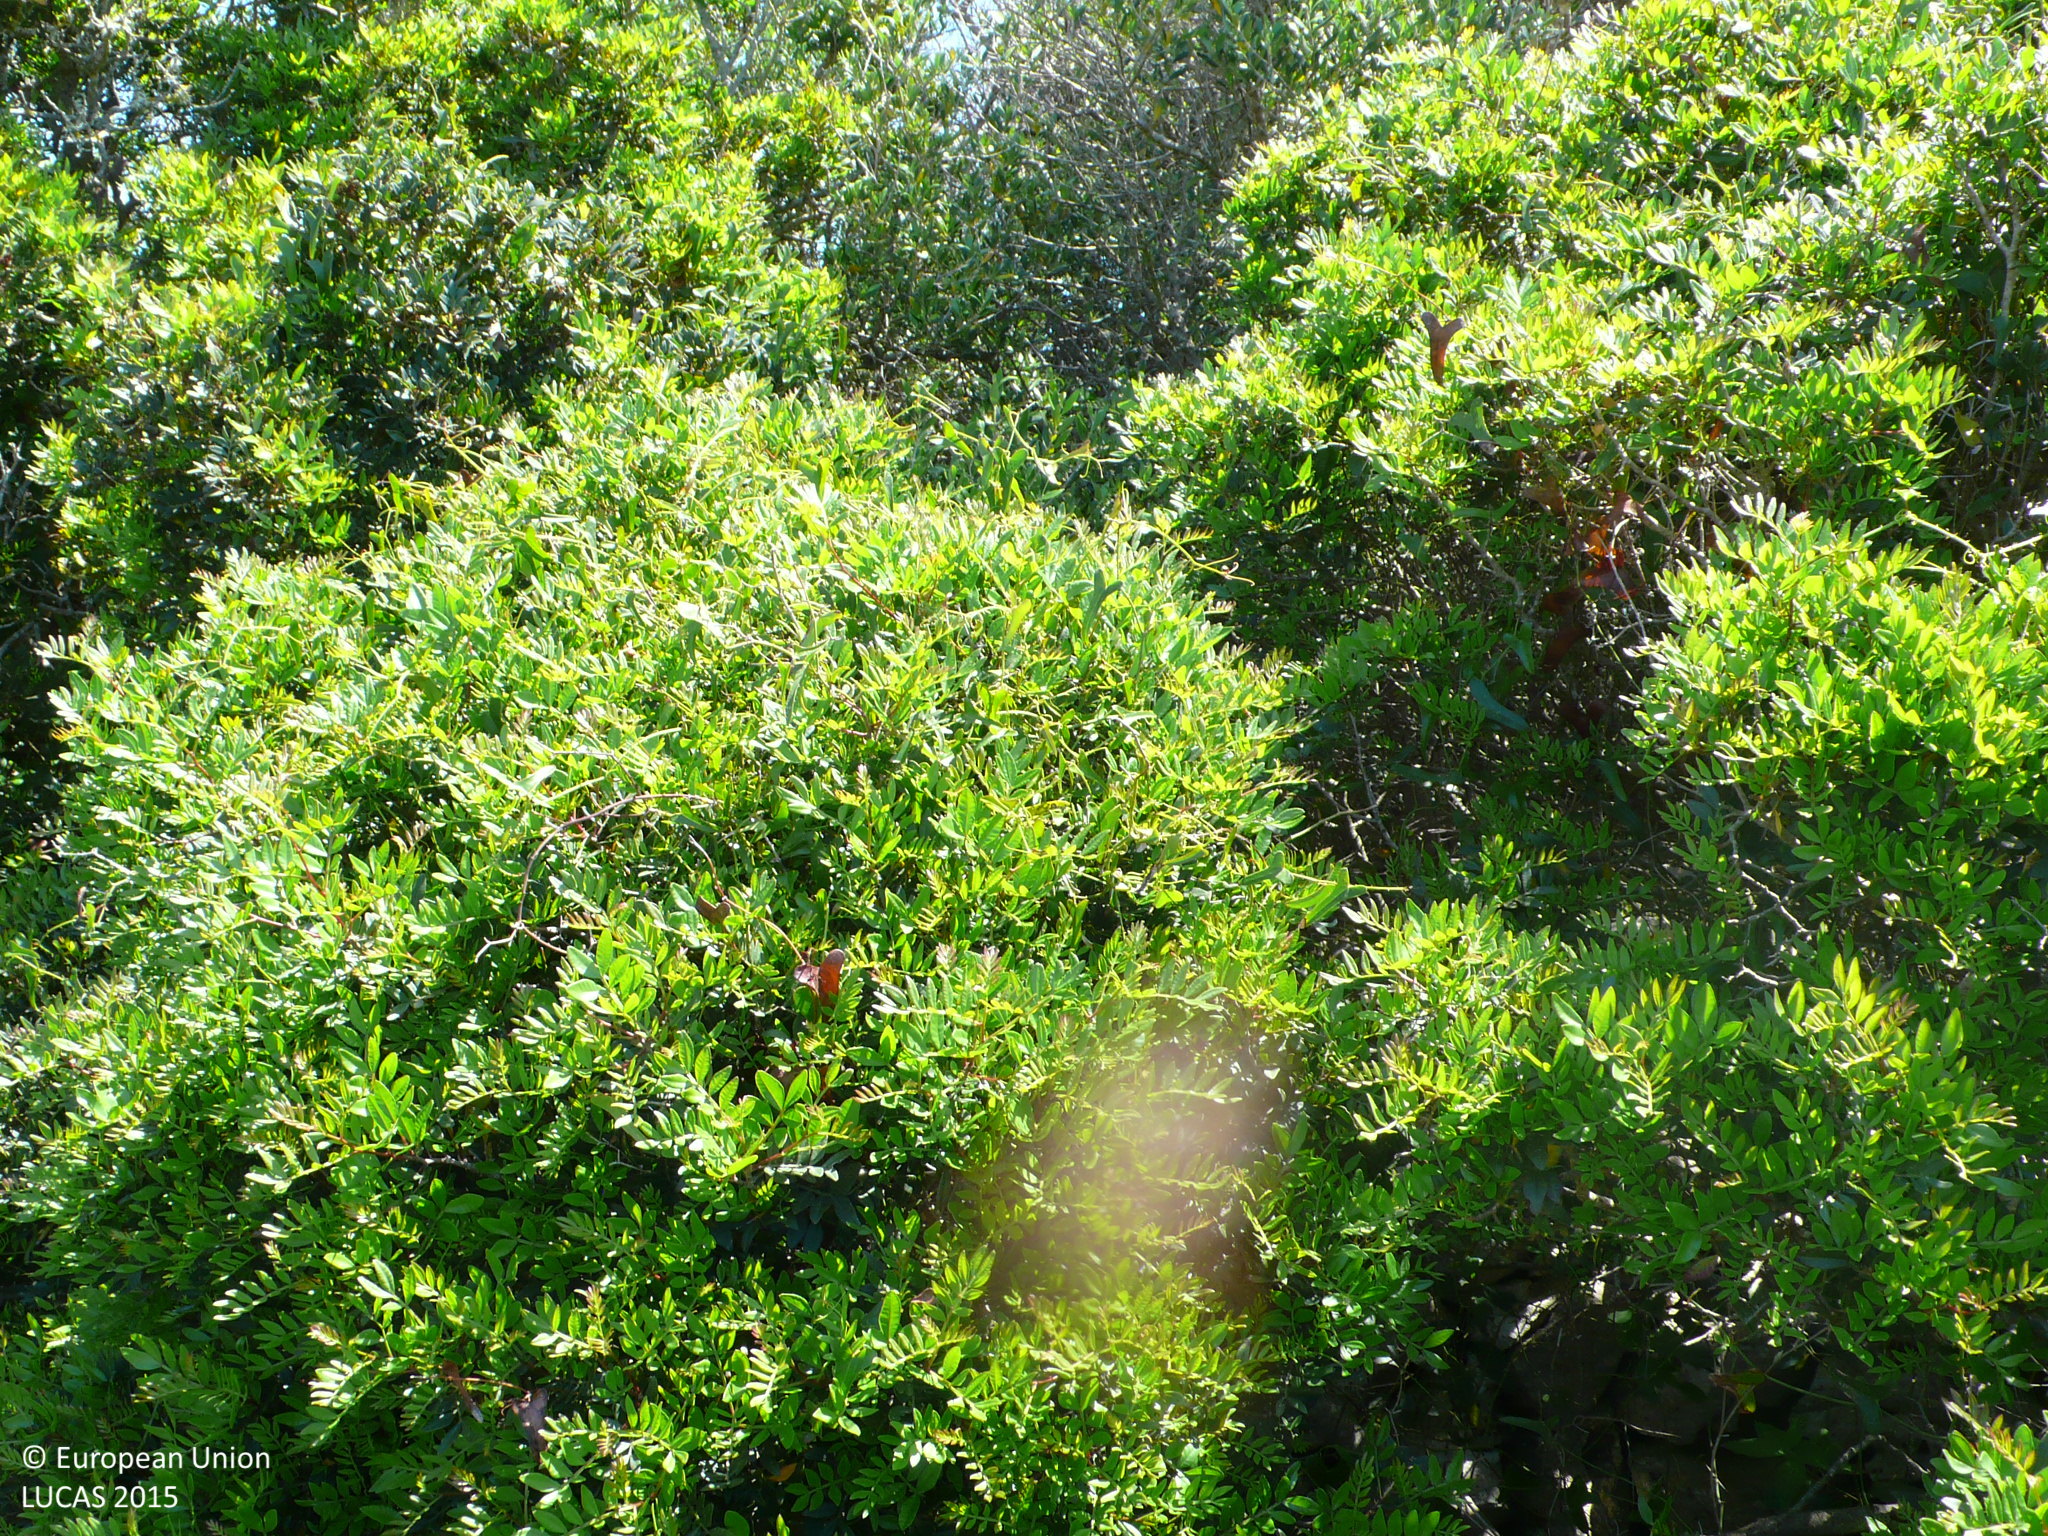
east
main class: Woodland
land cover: Broadleaved woodland
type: broadleaved evergreen forest
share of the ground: 10 - 25 %
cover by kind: shrubs 60 %, broadleaved forest trees 20 %, herbaceous plants 15 %, consolidated bare surface 5 %
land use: Semi-natural and natural areas not in use
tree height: < 5 m
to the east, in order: Broadleaved woodland; Dry stone walls; Broadleaved woodland; Tracks; Broadleaved woodland; Tracks; Broadleaved woodland
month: May
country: ES
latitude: 39.8260
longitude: 4.2430
